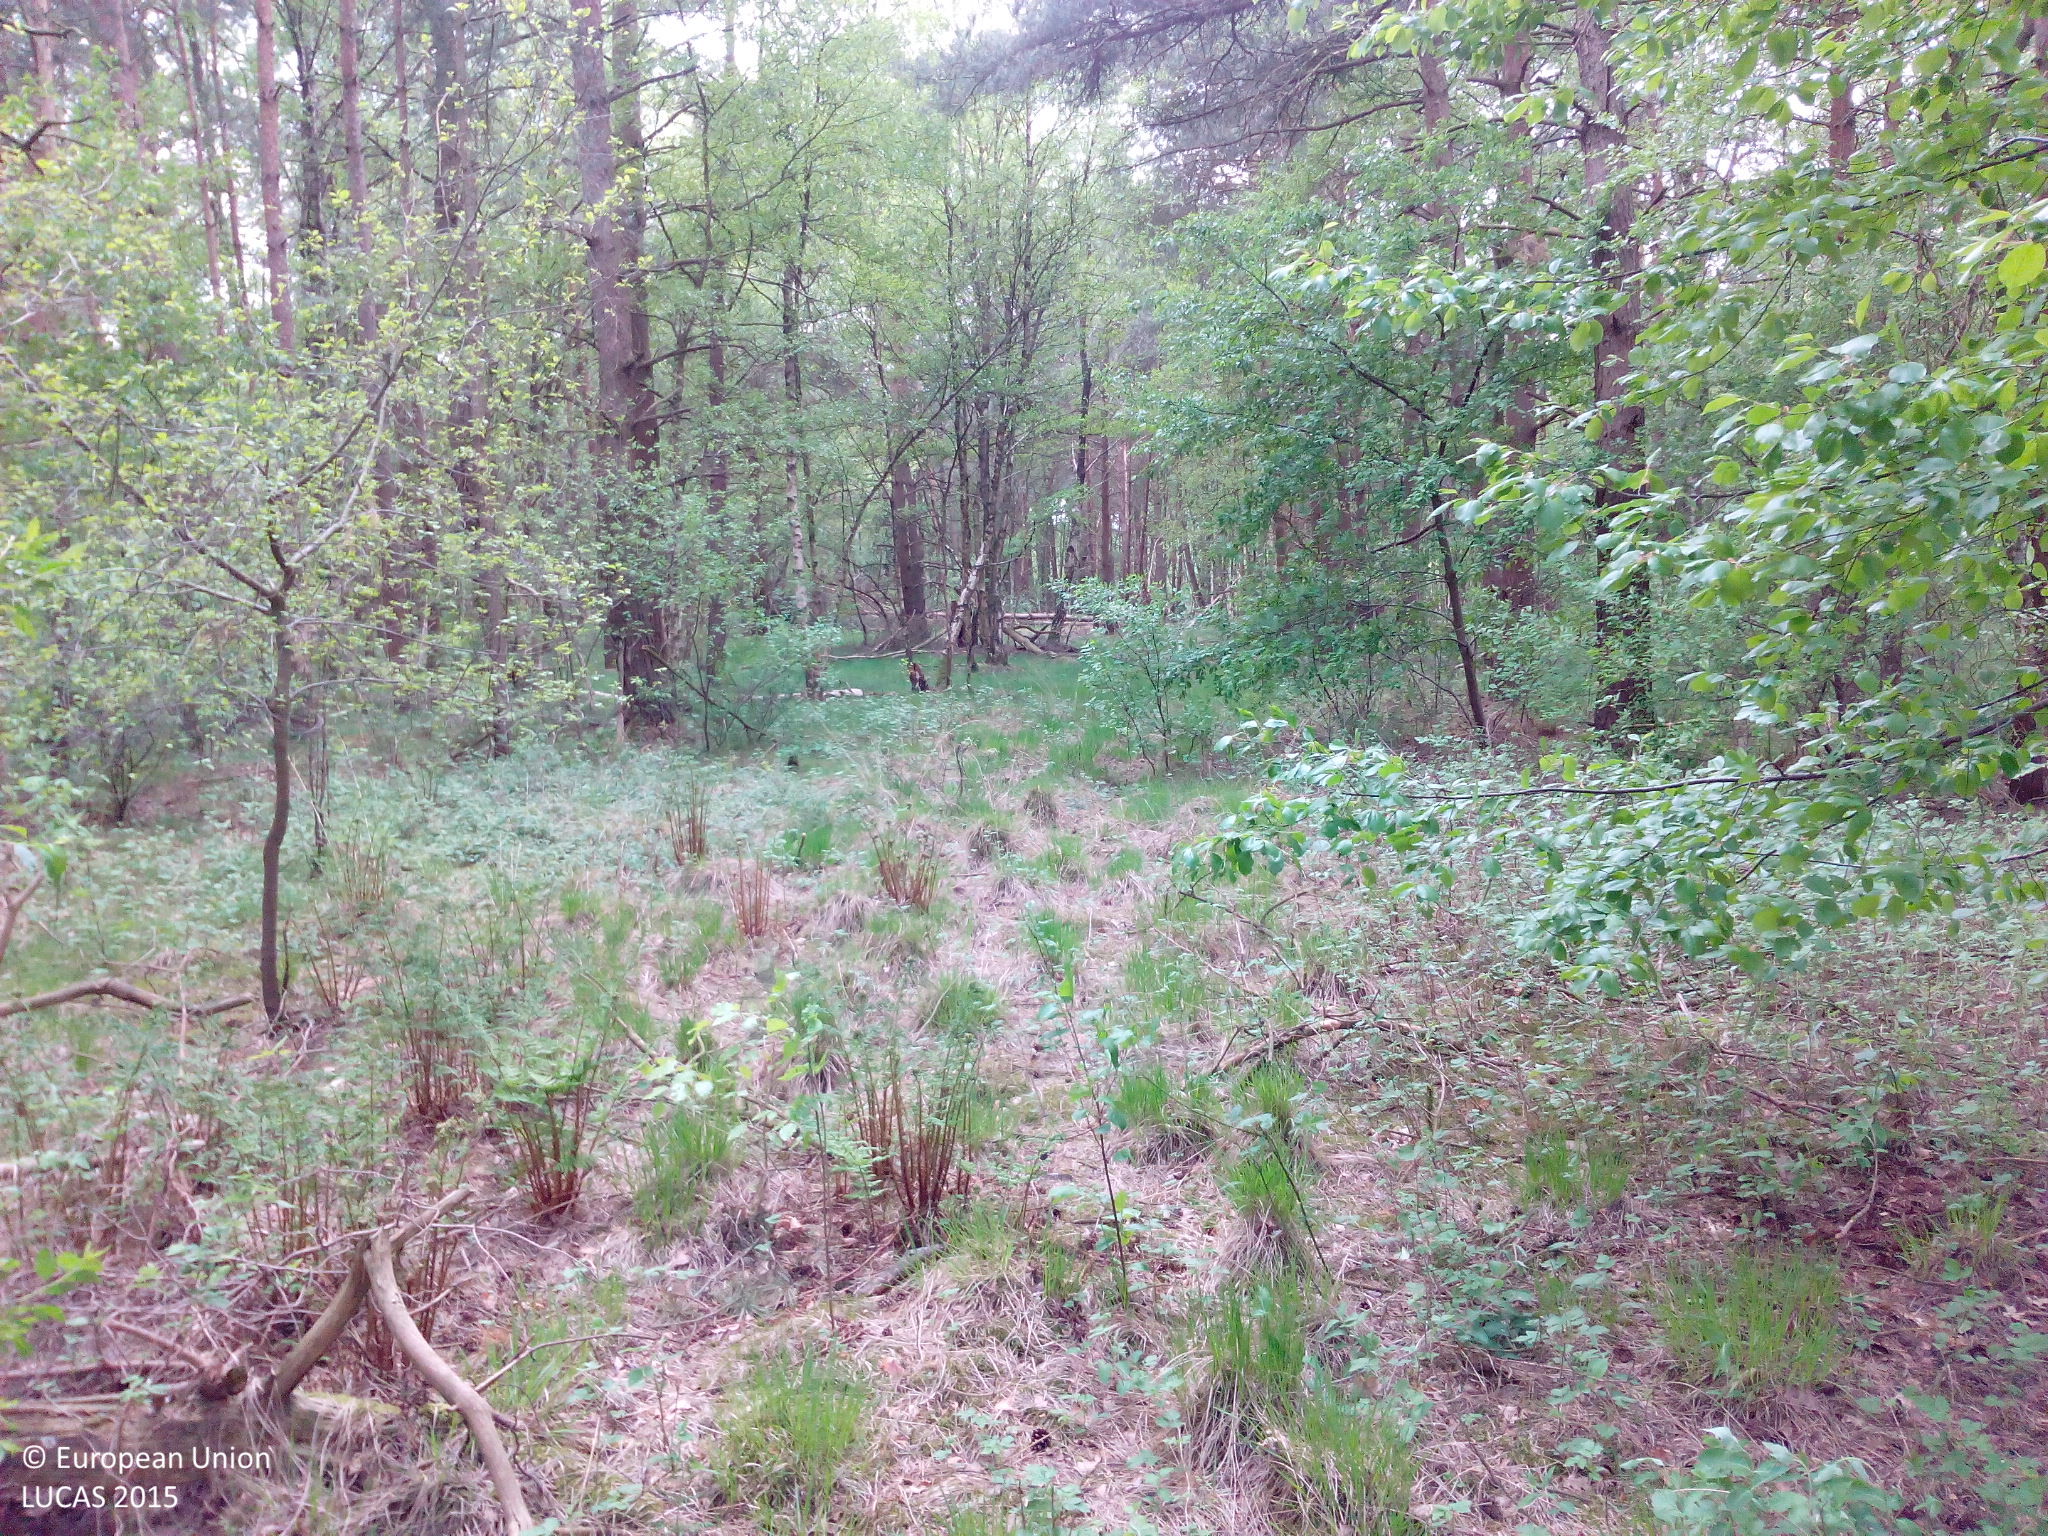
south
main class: Woodland
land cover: Pine dominated mixed woodland
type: hemiboreal forest and nemoral coniferous forest and mixed broadleaved-coniferous forest
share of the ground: > 75 %
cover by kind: coniferous forest trees 60 %, broadleaved forest trees 30 %, shrubs 5 %, herbaceous plants 5 %
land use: Forestry
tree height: > 5 m
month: May
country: DE
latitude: 53.1477
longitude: 9.2079
